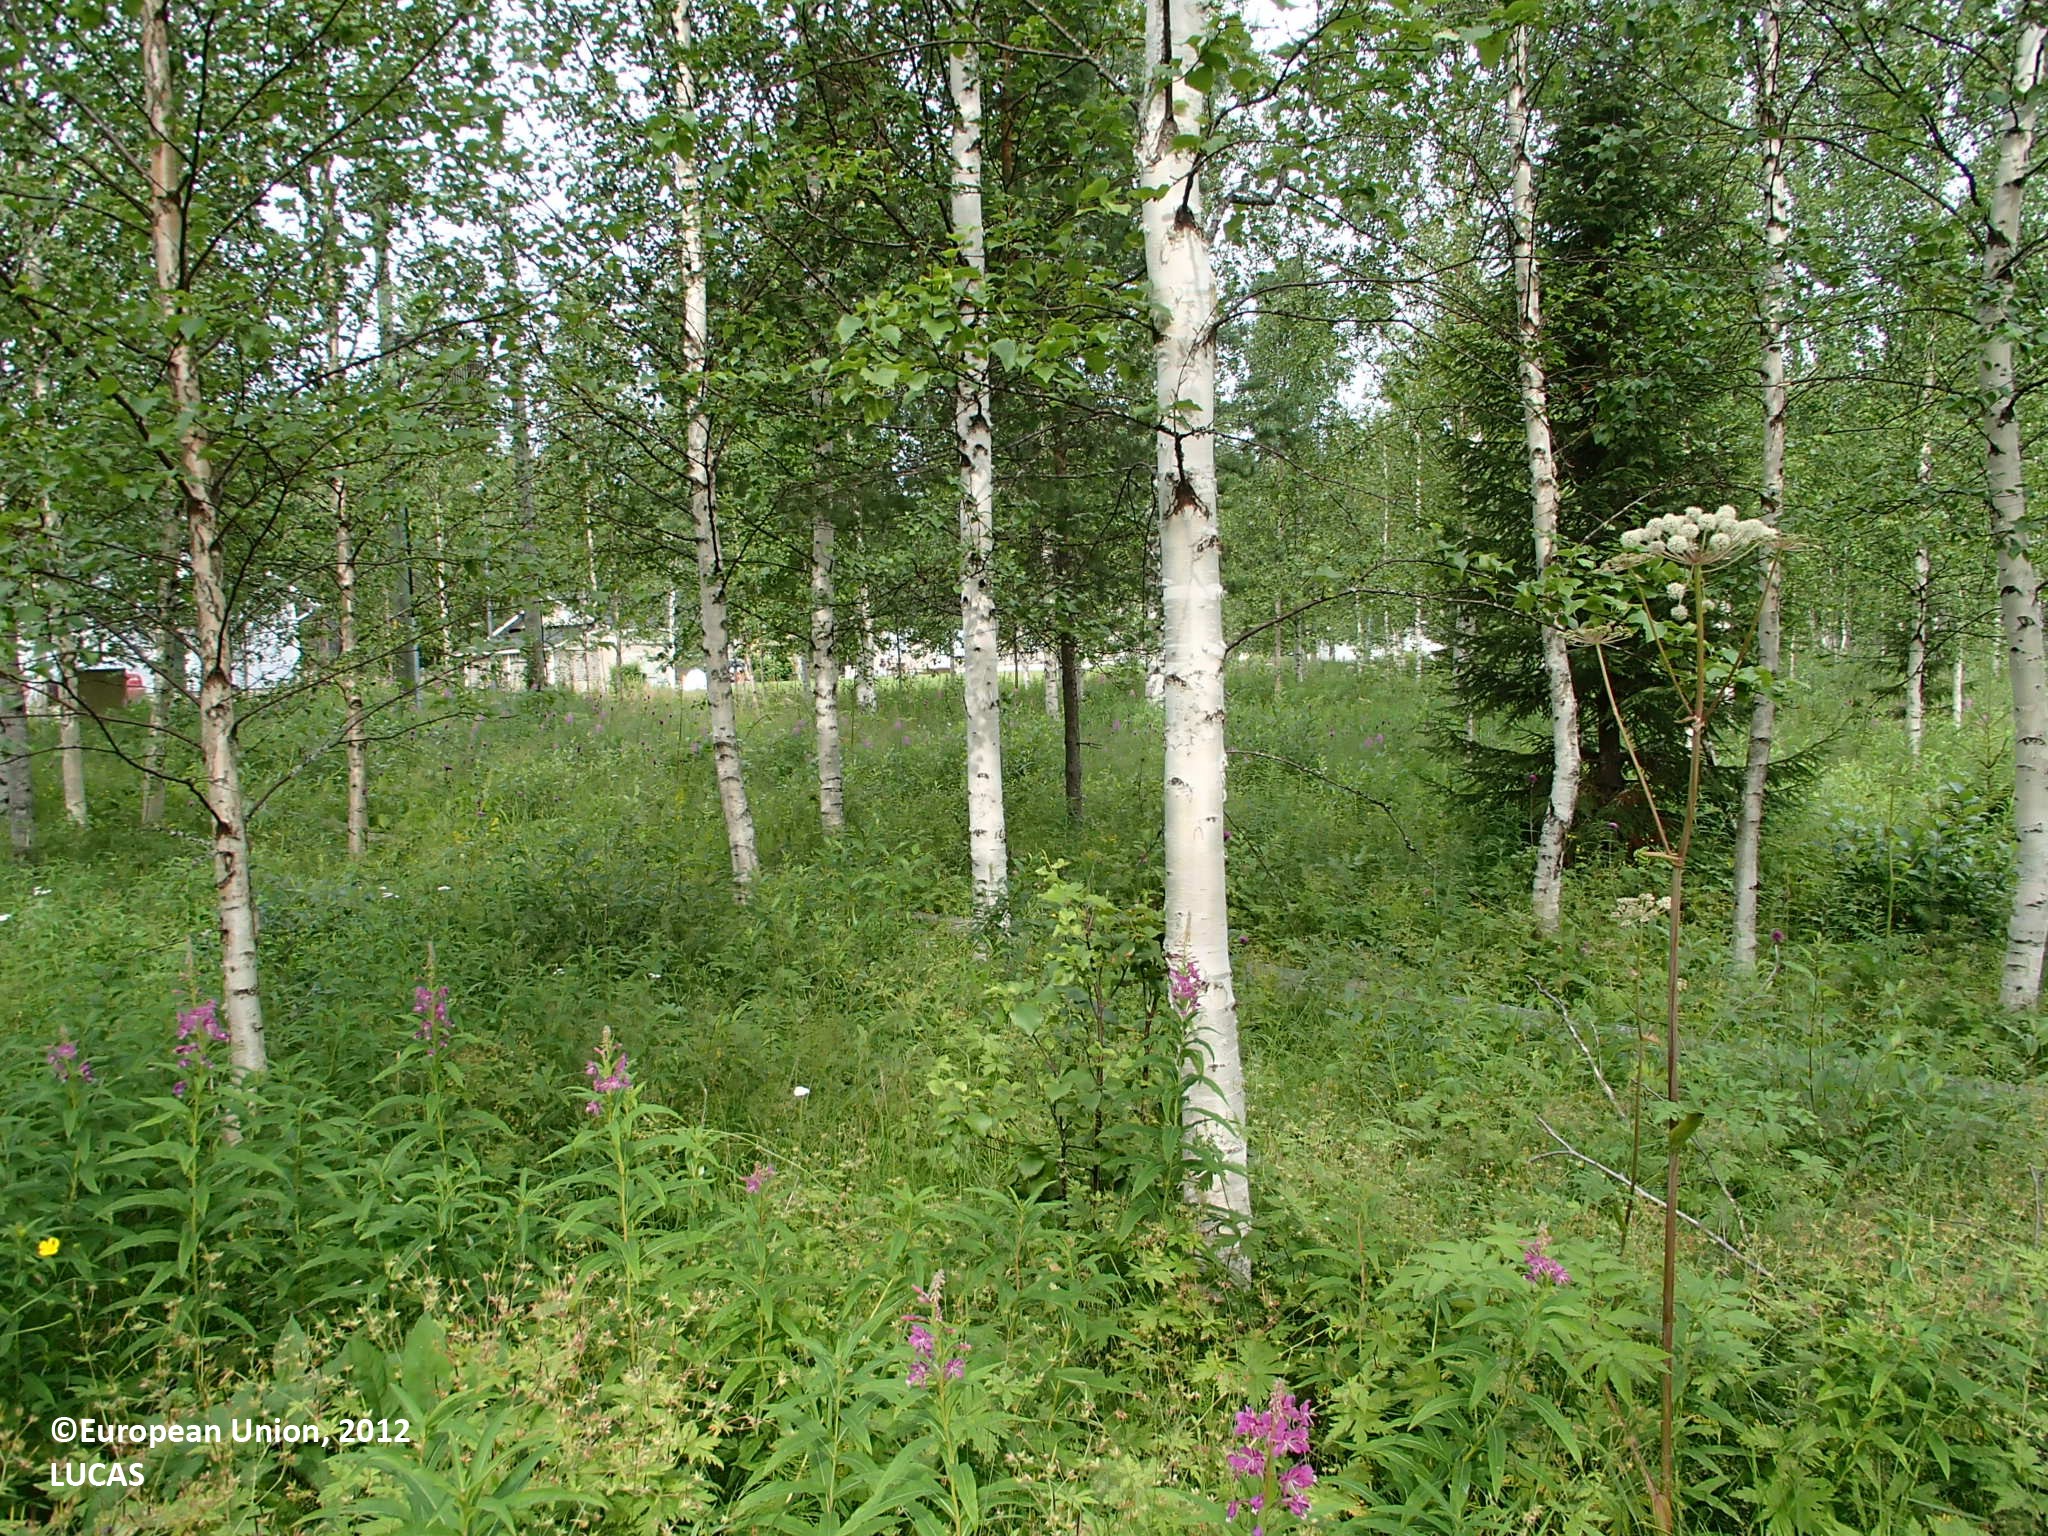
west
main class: Woodland
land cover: Broadleaved woodland
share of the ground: > 75 %
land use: Forestry
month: July
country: FI
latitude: 66.3800
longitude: 25.3842
